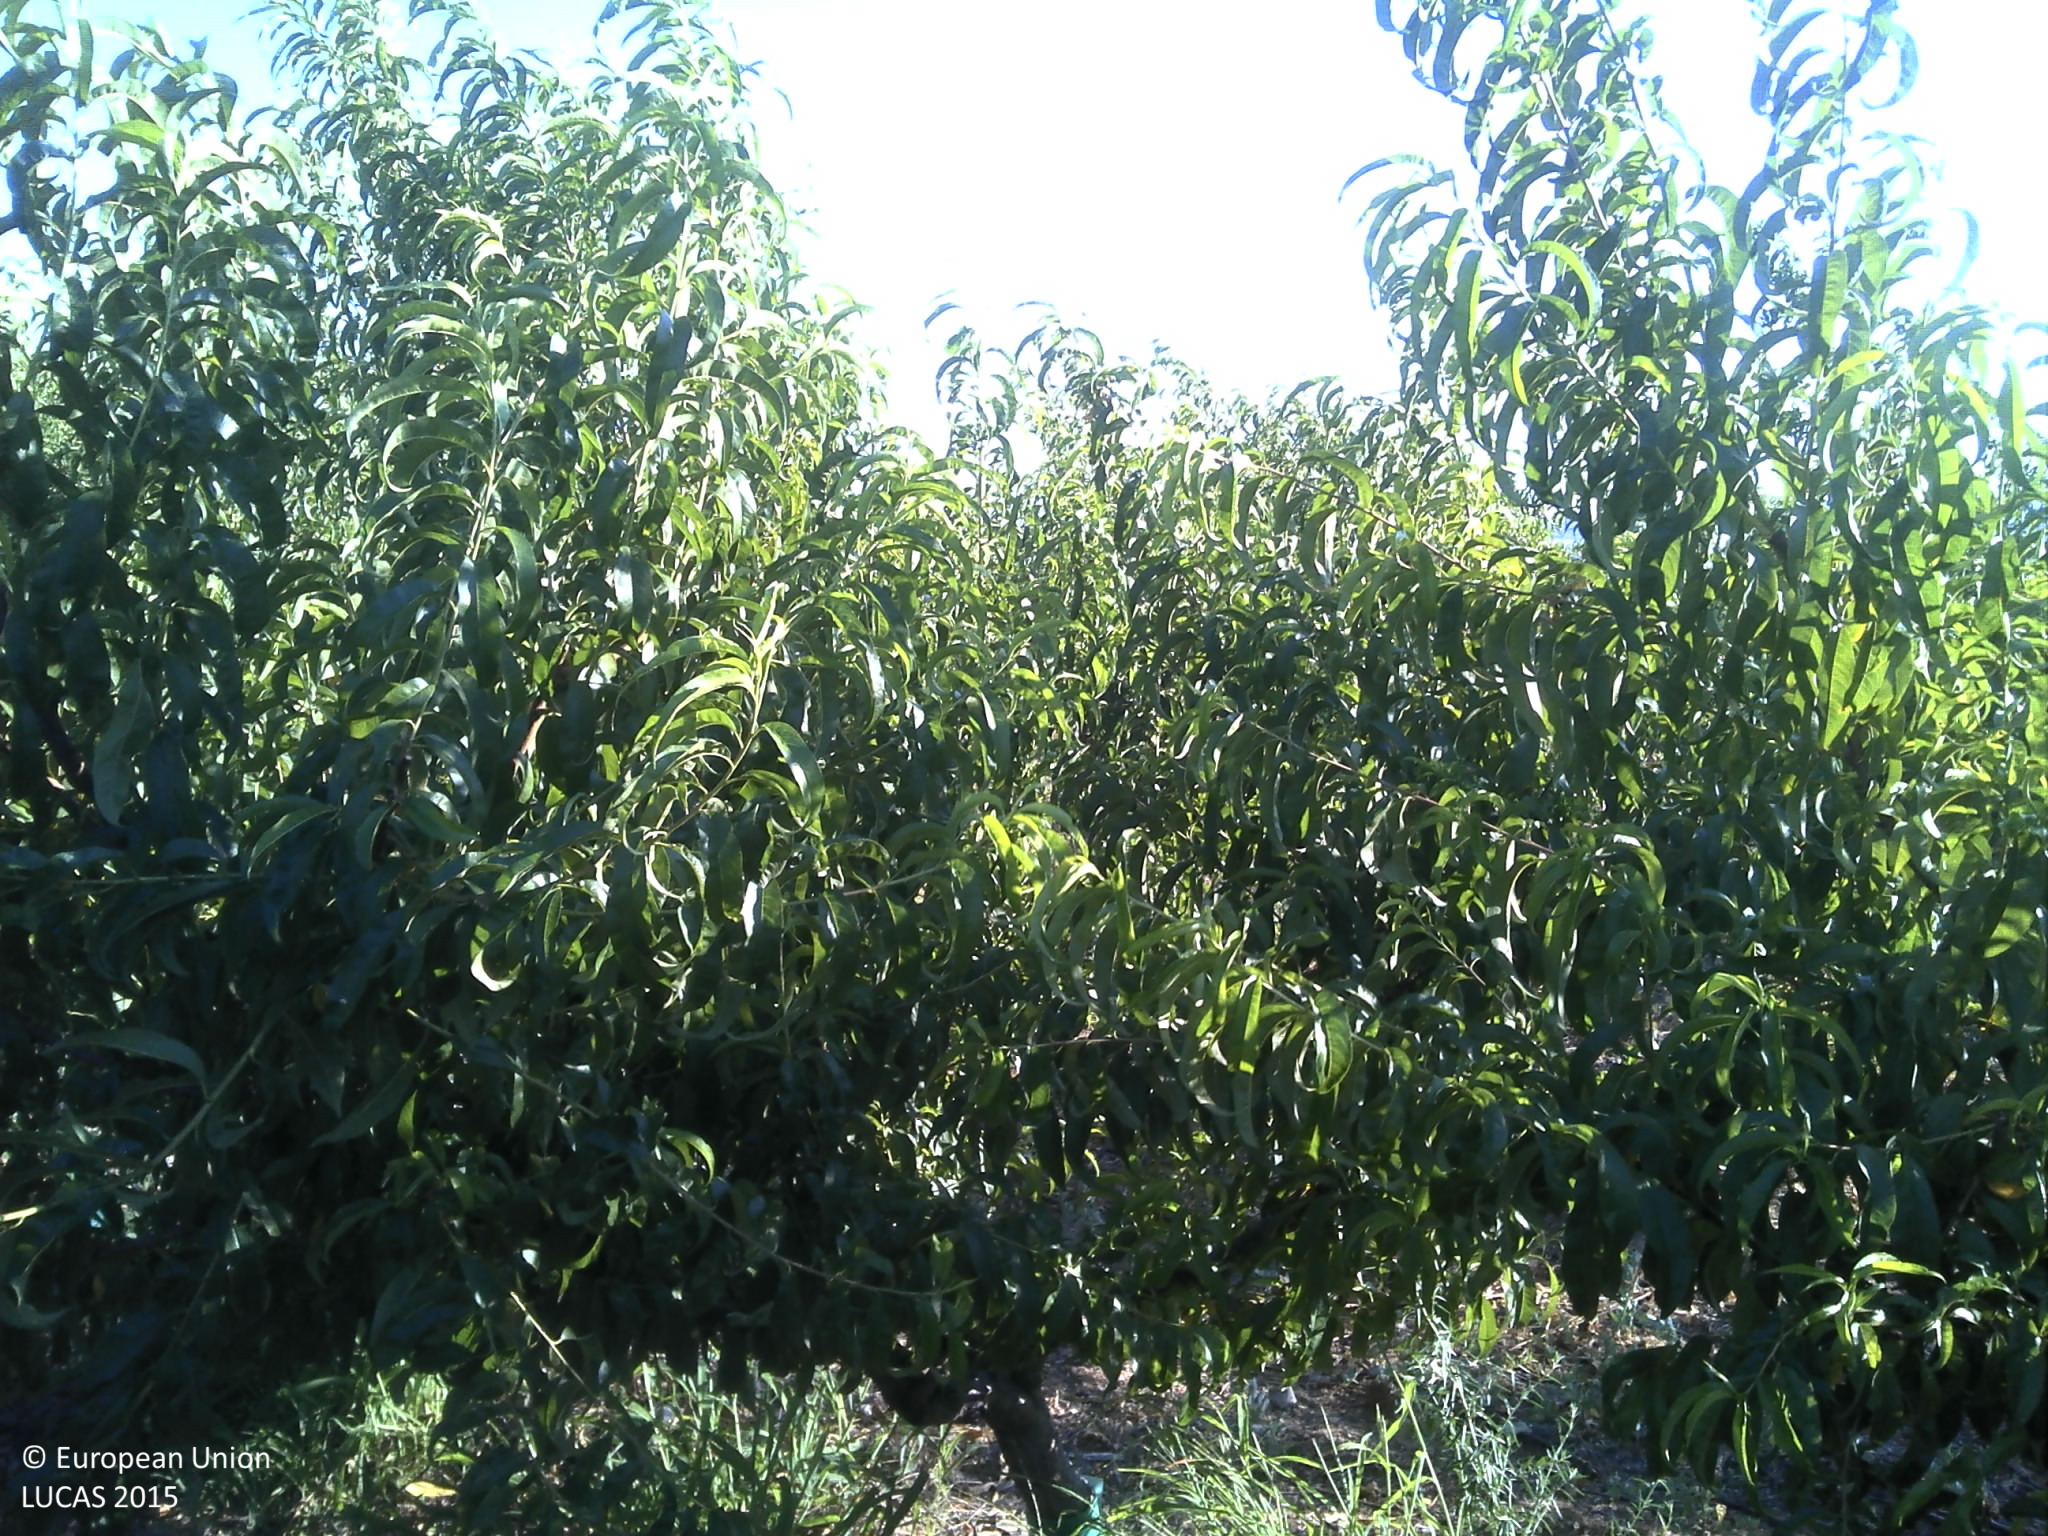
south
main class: Cropland
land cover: Other fruit trees and berries
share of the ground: 50 - 75 %
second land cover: Spontaneously vegetated surfaces
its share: 10 - 25 %
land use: Agriculture (excluding fallow land and kitchen gardens)
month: July
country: PT
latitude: 40.3415
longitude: -7.3990
